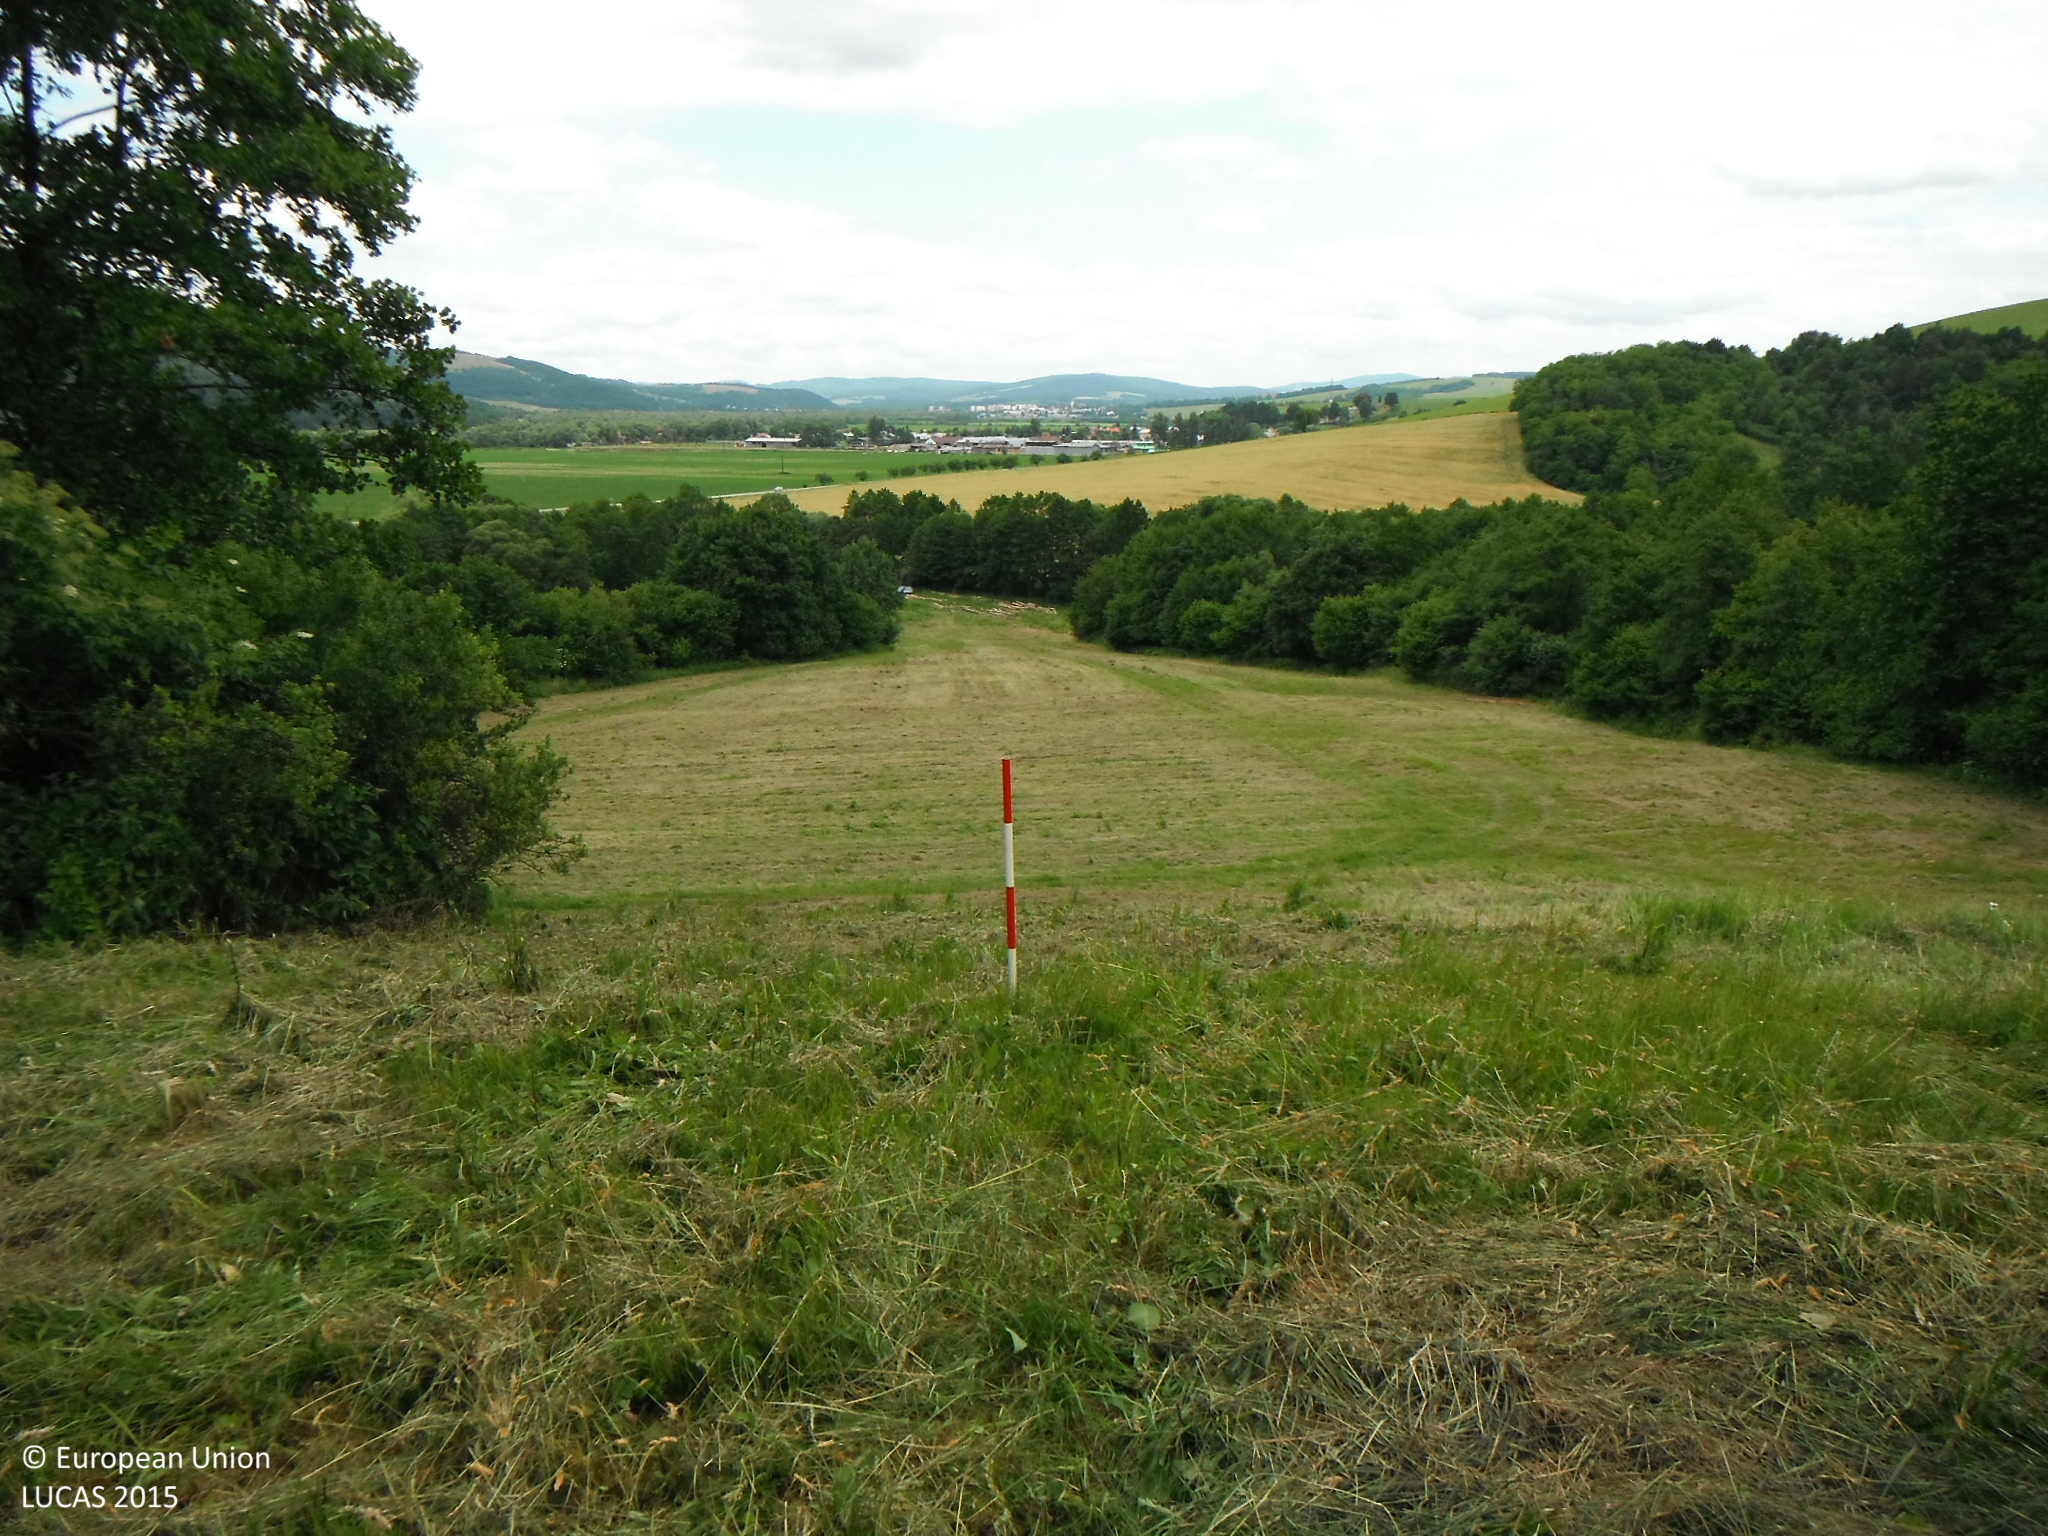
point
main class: Grassland
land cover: Grassland without tree/shrub cover
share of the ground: > 75 %
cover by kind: herbaceous plants 100 %
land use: Agriculture (excluding fallow land and kitchen gardens)
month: June
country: SK
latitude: 49.1472
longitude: 21.6628
